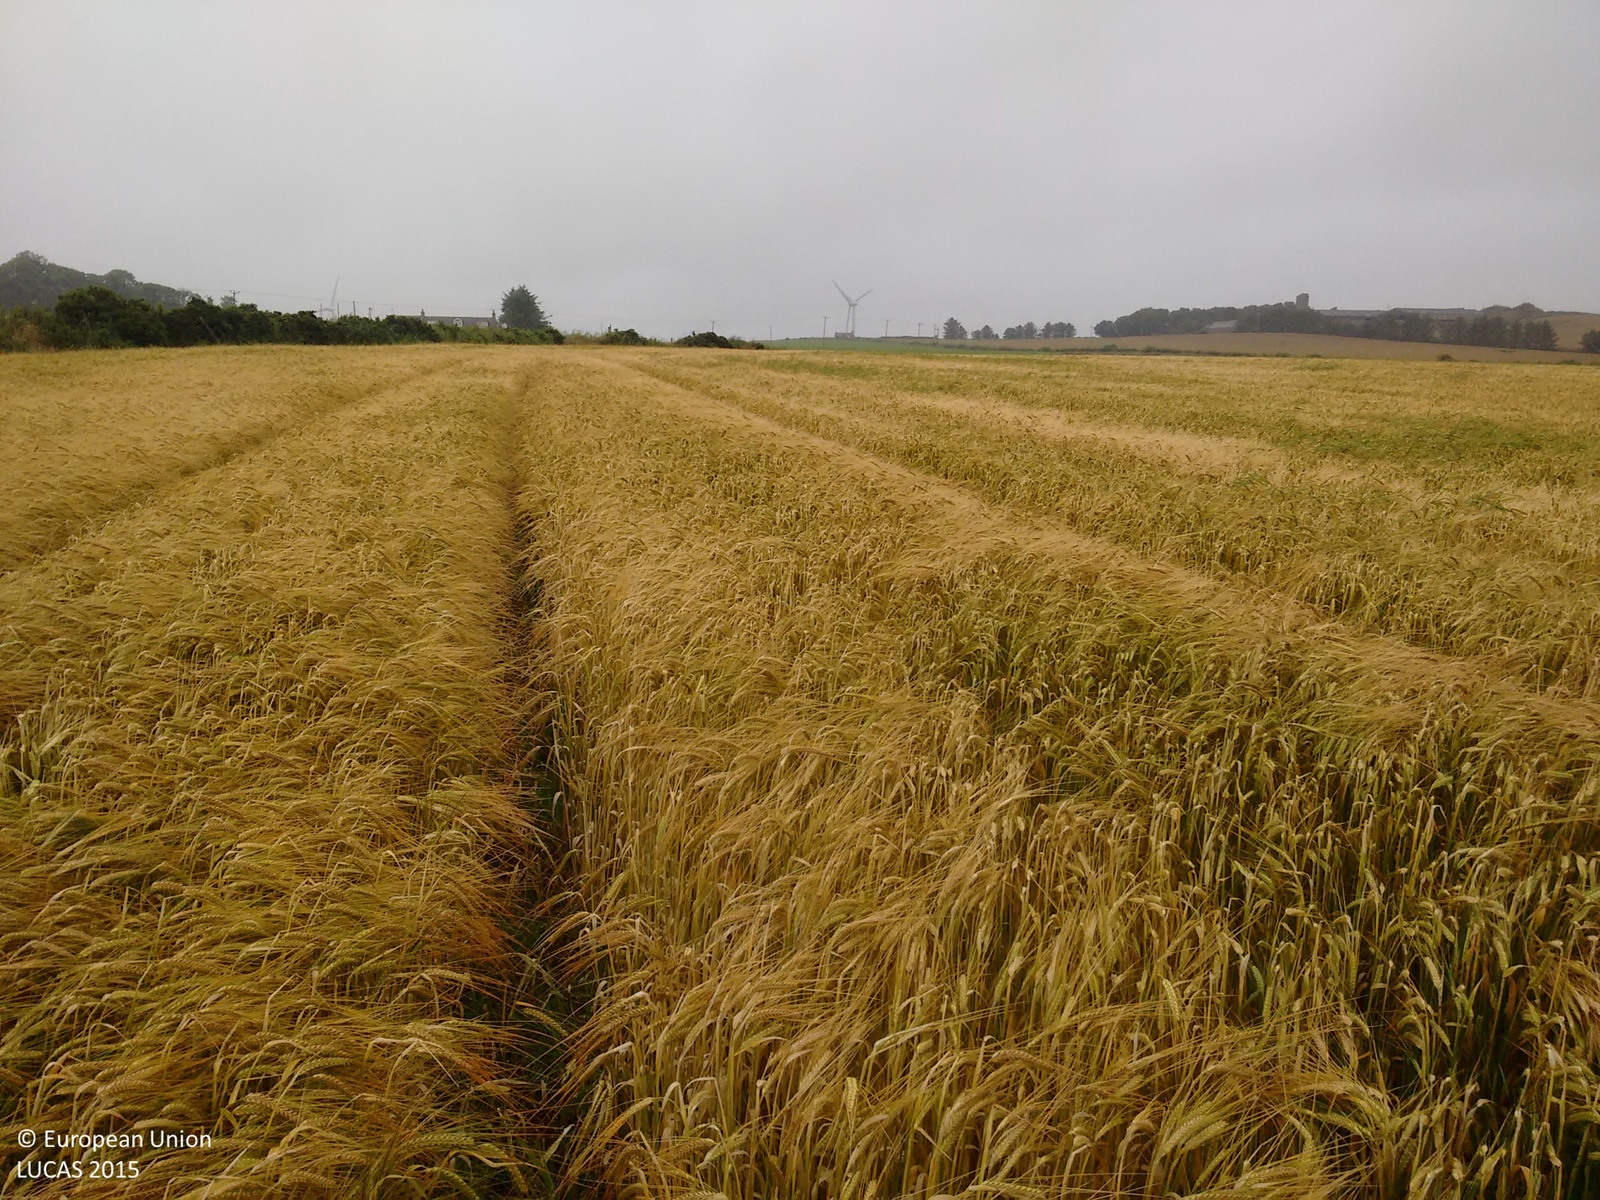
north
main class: Cropland
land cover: Barley
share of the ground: > 75 %
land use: Agriculture (excluding fallow land and kitchen gardens)
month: August
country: GB
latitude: 57.3047
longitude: -2.1149
